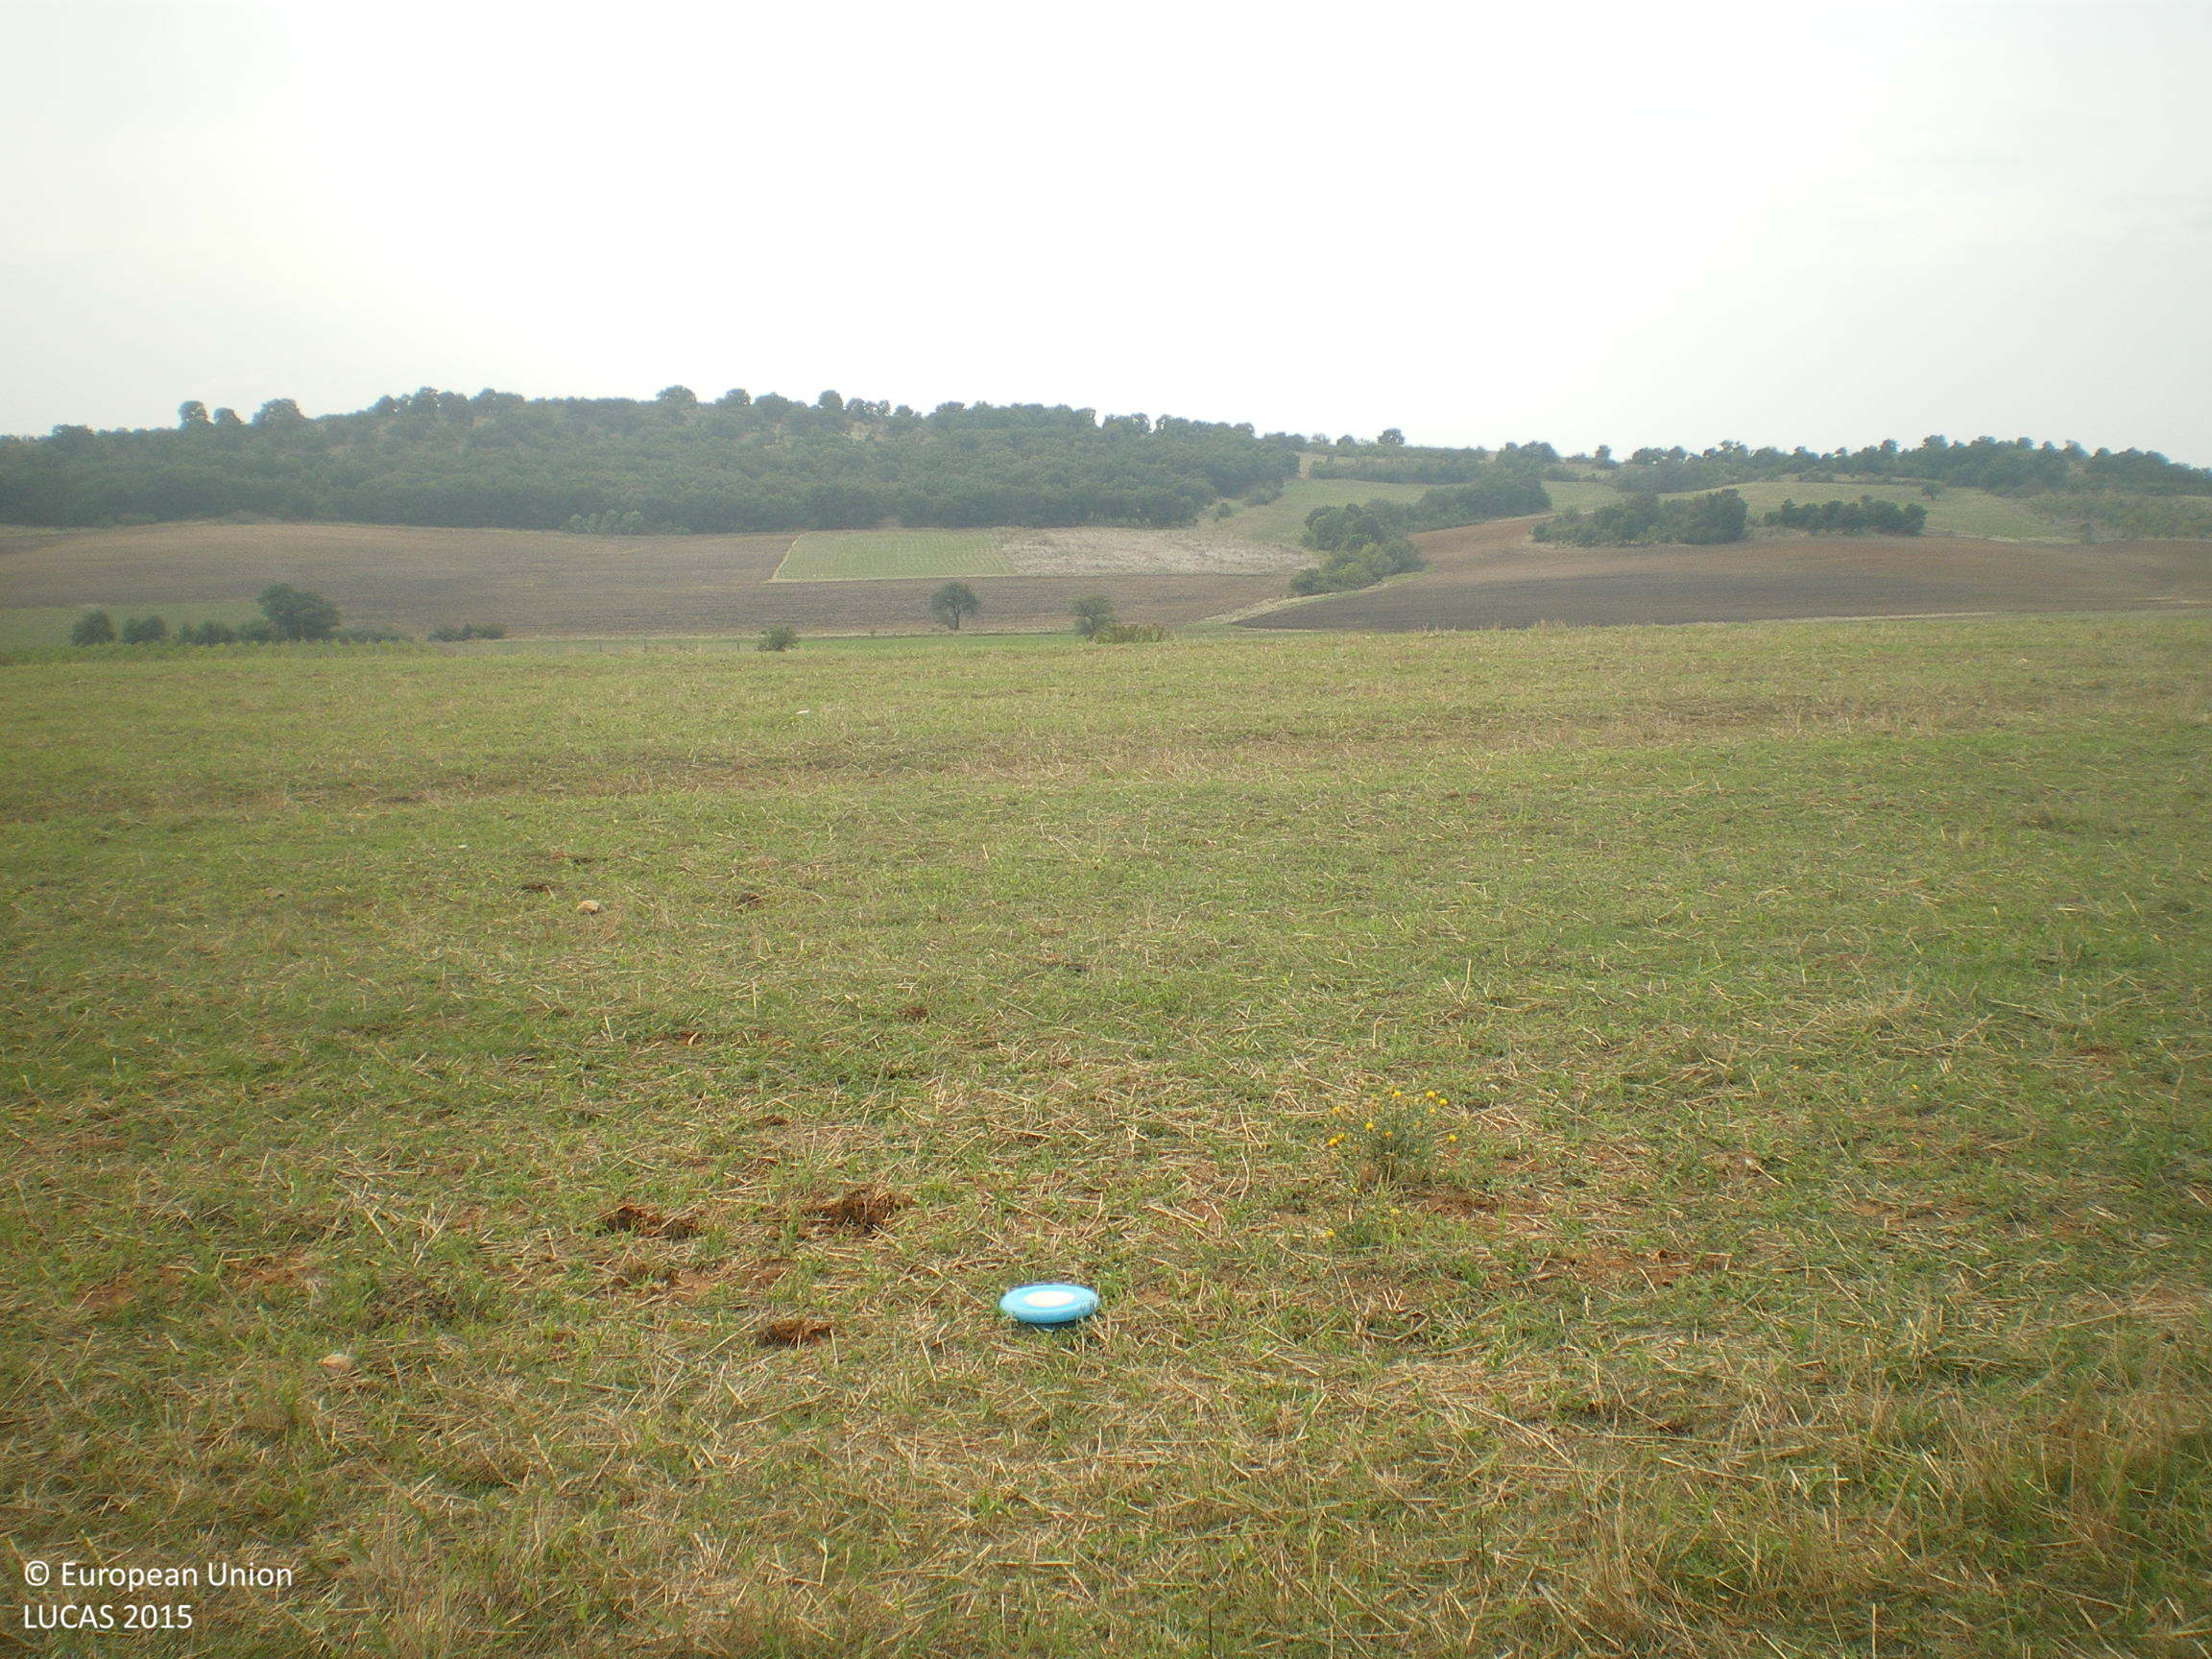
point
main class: Cropland
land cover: Common wheat
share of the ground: < 10 %
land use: Agriculture (excluding fallow land and kitchen gardens)
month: September
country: BG
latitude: 41.8819
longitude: 25.9176
